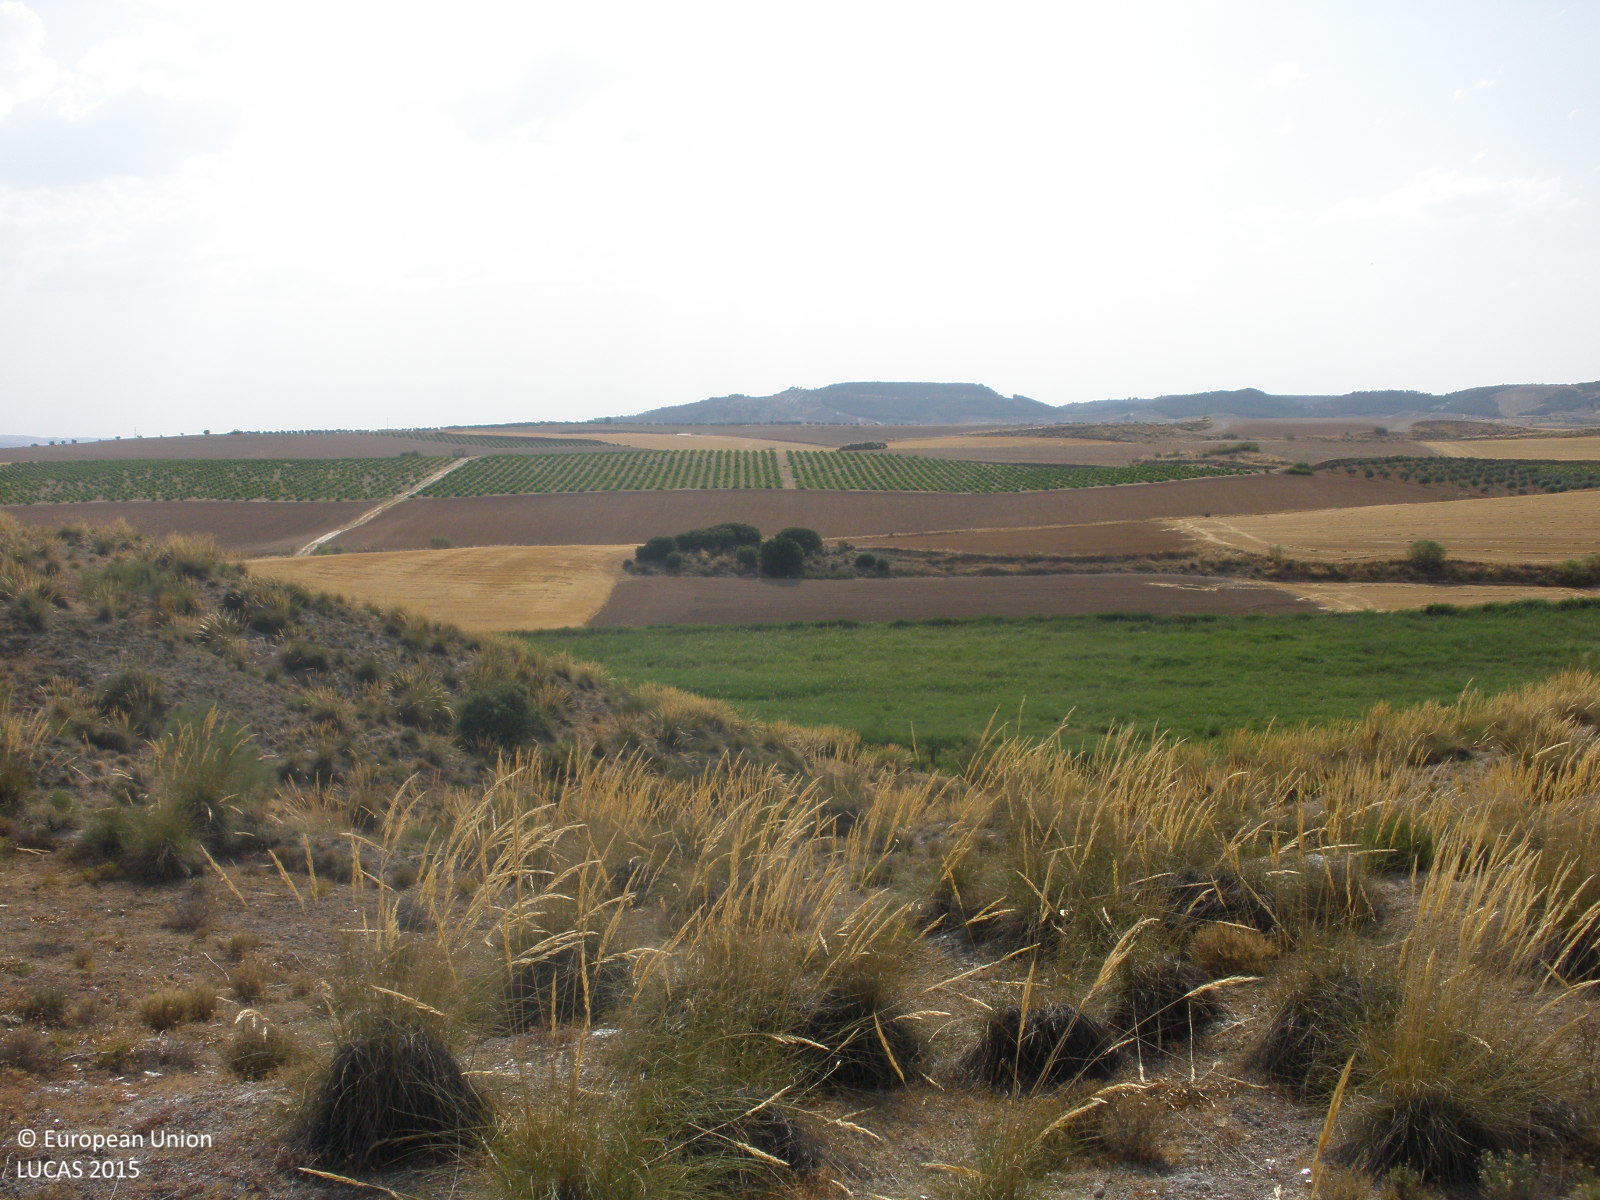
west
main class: Shrubland
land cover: Shrubland without tree cover
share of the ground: 25 - 50 %
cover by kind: shrubs 40 %, herbaceous plants 30 %, consolidated bare surface 30 %
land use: Semi-natural and natural areas not in use
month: July
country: ES
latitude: 40.0633
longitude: -3.3589
